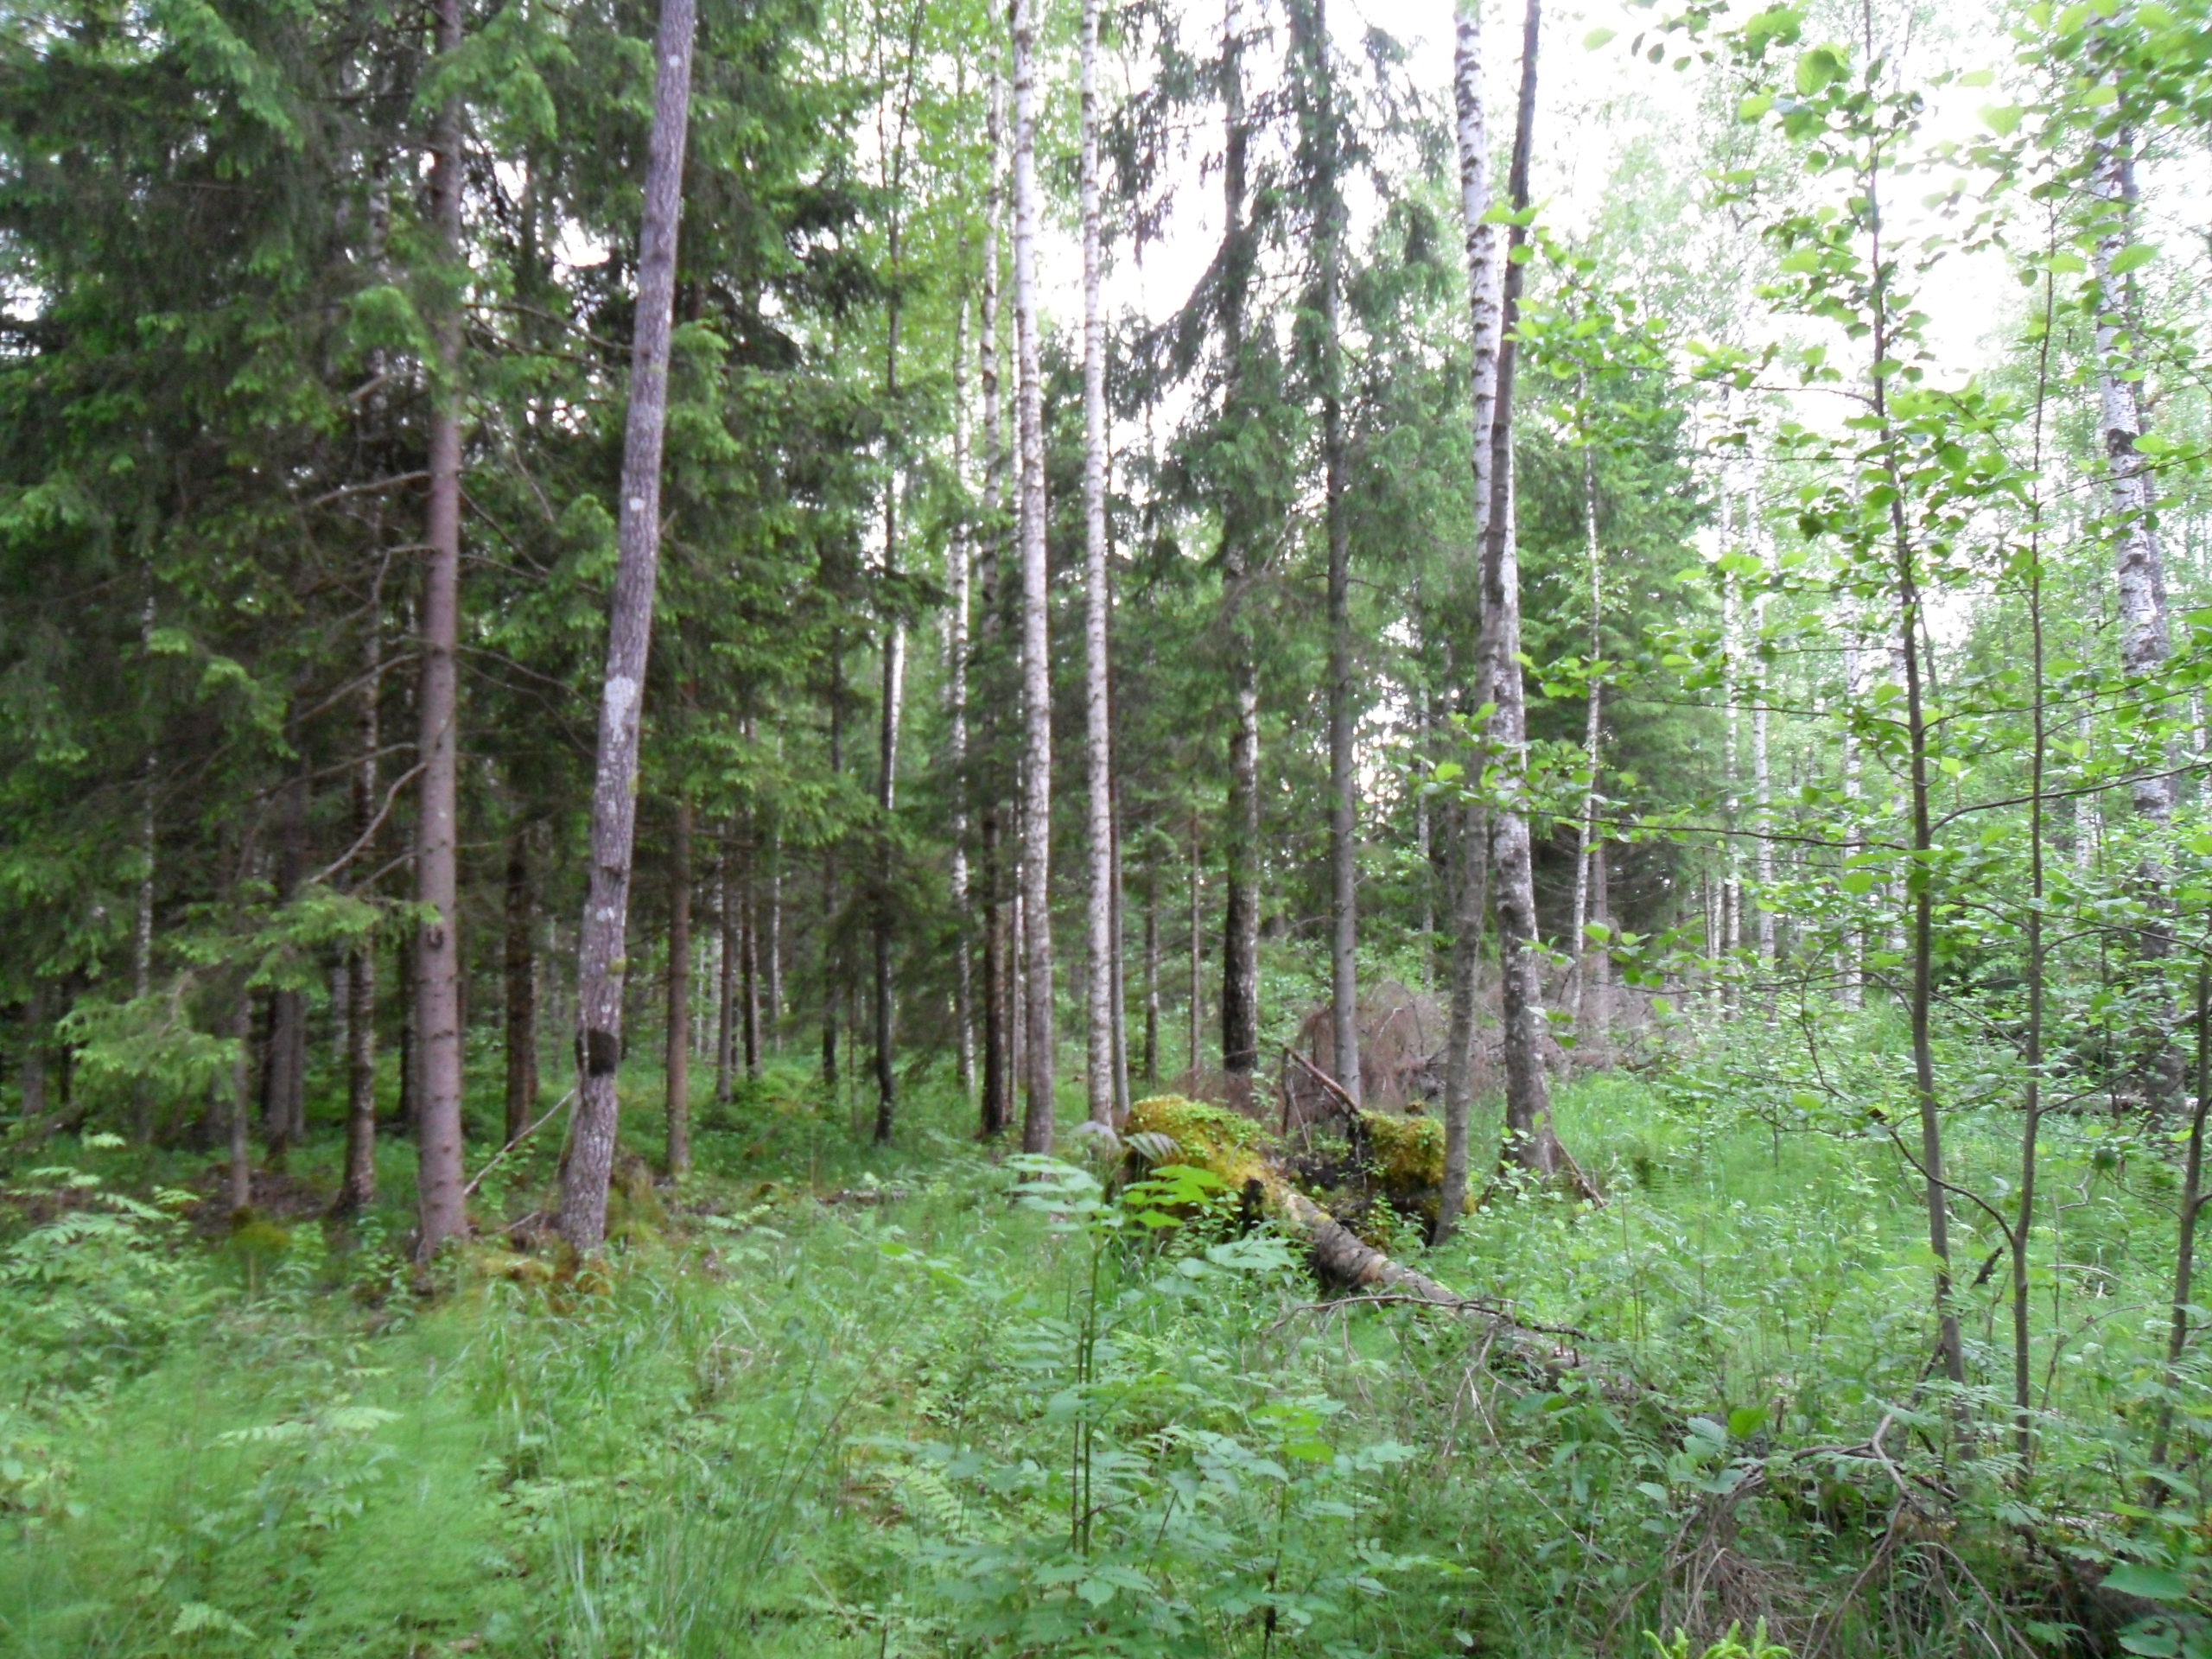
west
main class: Woodland
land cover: Other mixed woodland
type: hemiboreal forest and nemoral coniferous forest and mixed broadleaved-coniferous forest
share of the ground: 50 - 75 %
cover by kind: coniferous forest trees 40 %, broadleaved forest trees 30 %, herbaceous plants 20 %, shrubs 10 %
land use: Forestry
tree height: > 5 m
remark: Temporary flooded
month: June
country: LV
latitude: 57.4875
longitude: 22.1074
